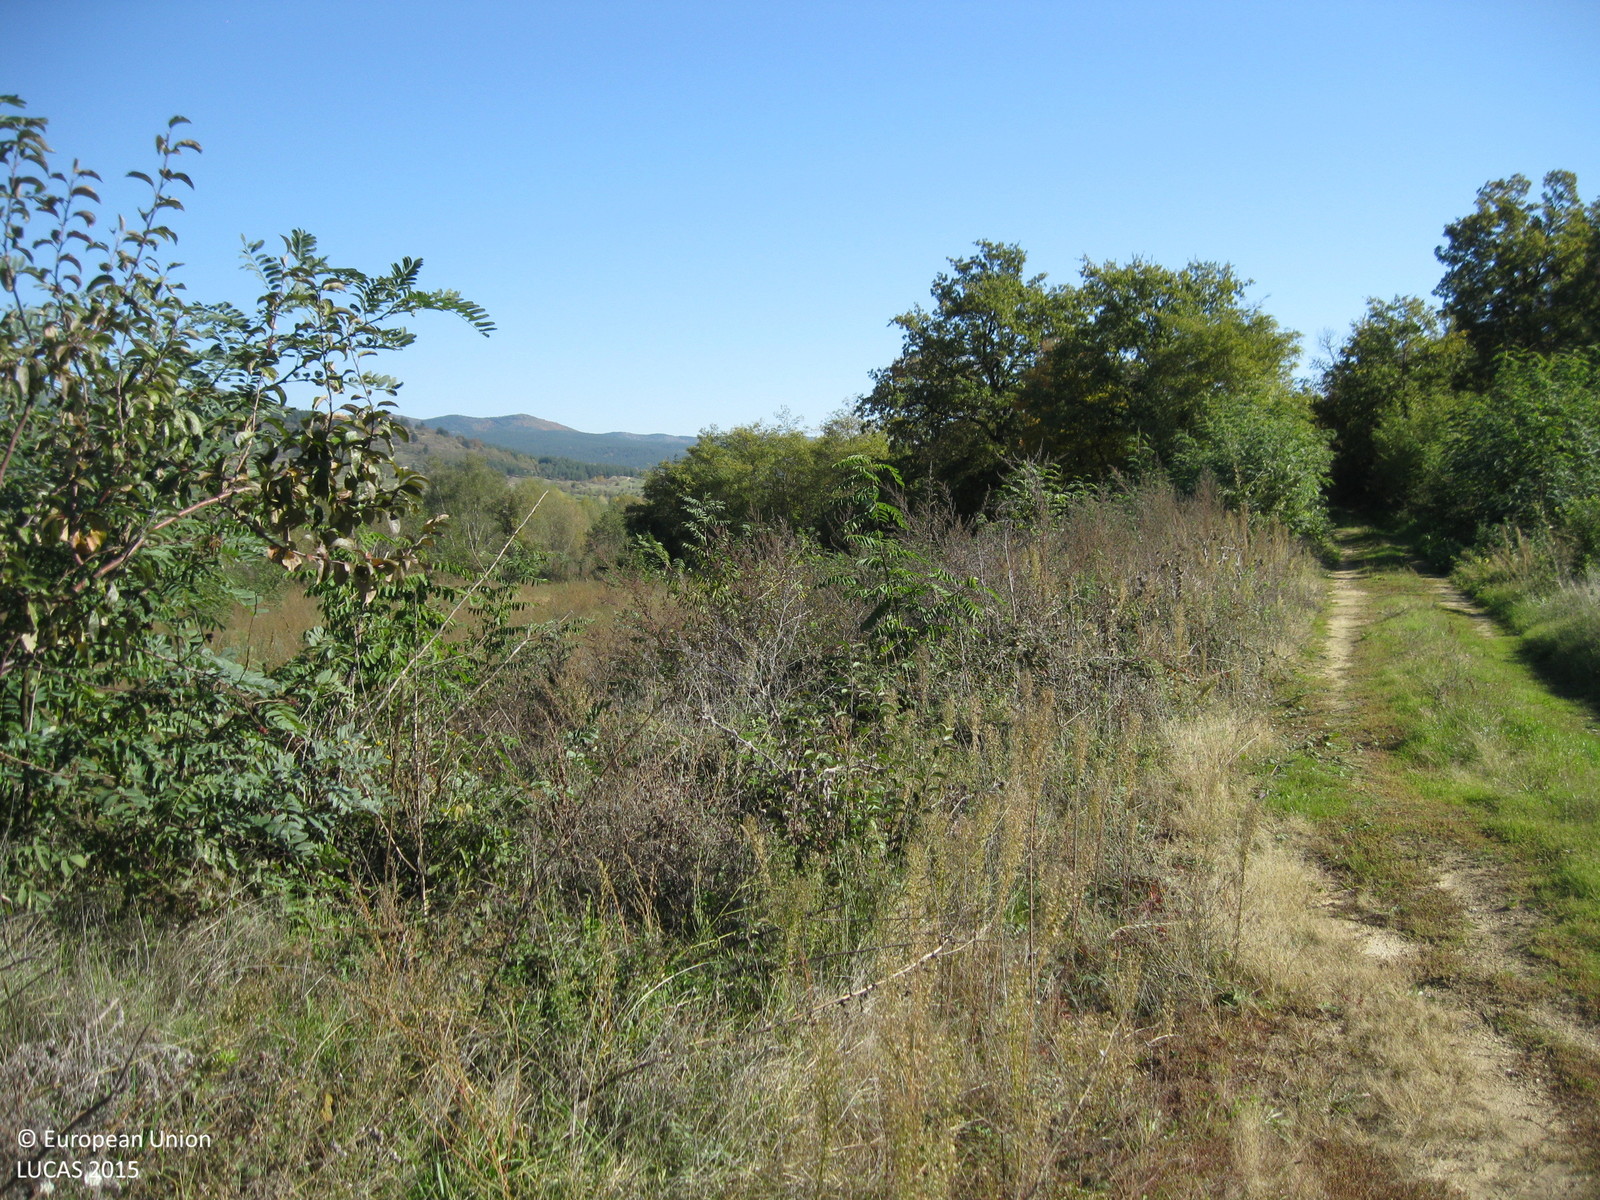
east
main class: Shrubland
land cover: Shrubland without tree cover
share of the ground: > 75 %
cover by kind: shrubs 90 %, herbaceous plants 10 %
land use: Fallow land
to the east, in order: Shrubland without tree cover; Broadleaved woodland; Grassland without tree/shrub cover; Single bushes/trees; Inland fresh running water; Broadleaved woodland
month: November
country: BG
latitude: 42.3591
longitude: 24.0900
